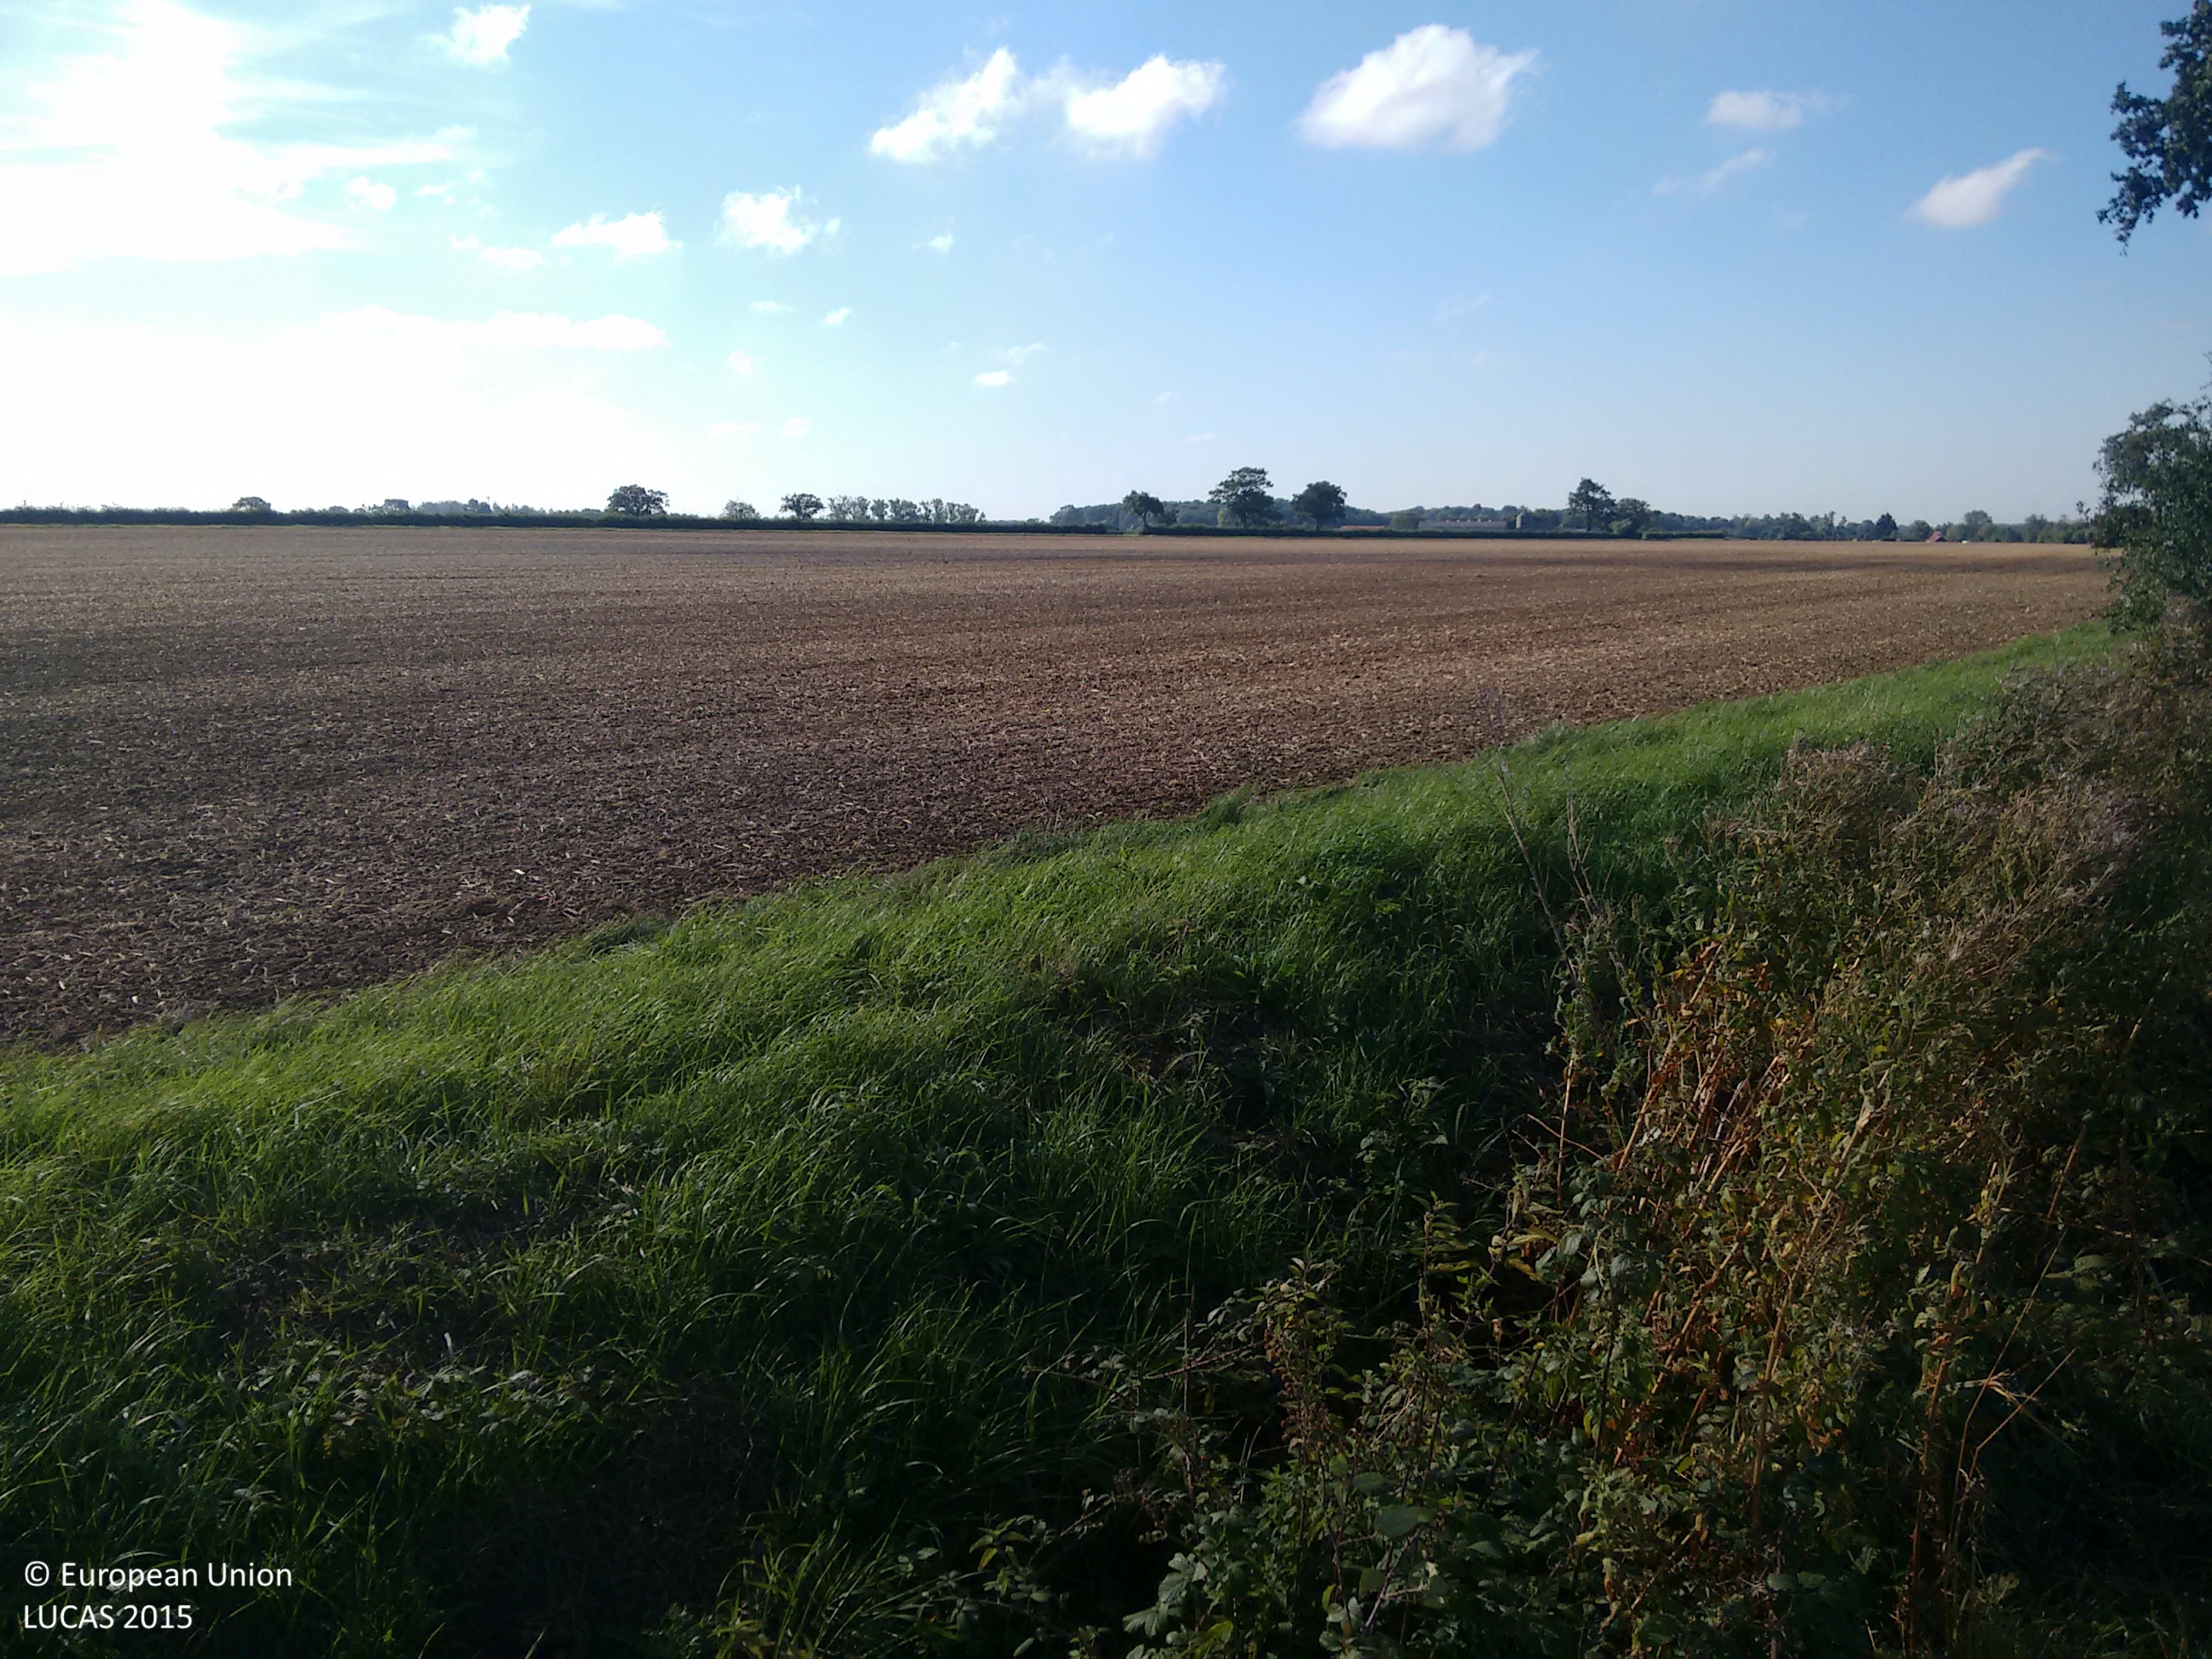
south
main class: Cropland
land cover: Common wheat
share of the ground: 10 - 25 %
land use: Agriculture (excluding fallow land and kitchen gardens)
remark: Harvested field
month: September
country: GB
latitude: 52.2089
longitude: 1.3897
